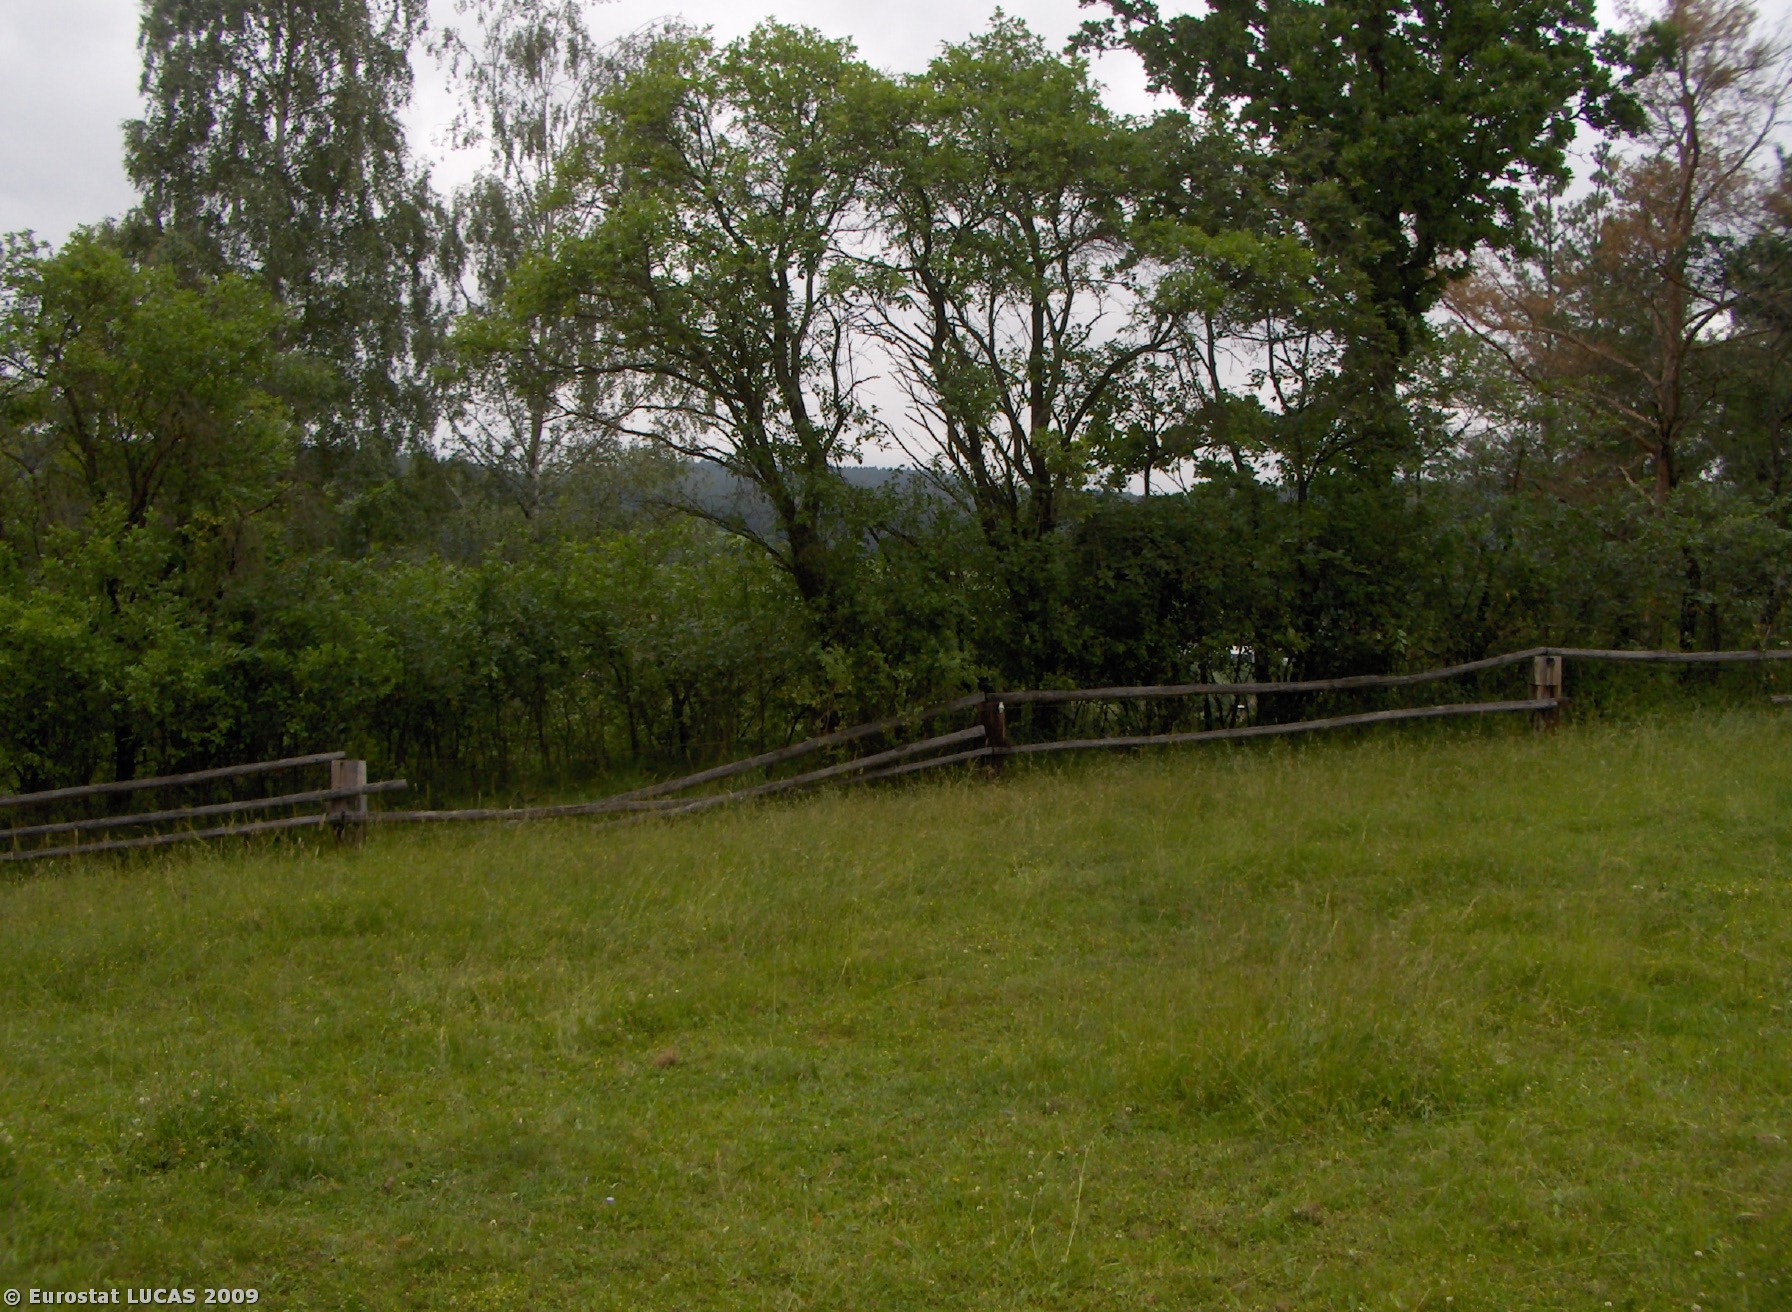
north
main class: Woodland
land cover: Mixed woodland
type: hemiboreal forest and nemoral coniferous forest and mixed broadleaved-coniferous forest
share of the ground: > 75 %
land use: Forestry
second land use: Agriculture (excluding fallow land and kitchen gardens)
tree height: > 5 m
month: June
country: CZ
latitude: 49.7761
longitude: 14.3756
